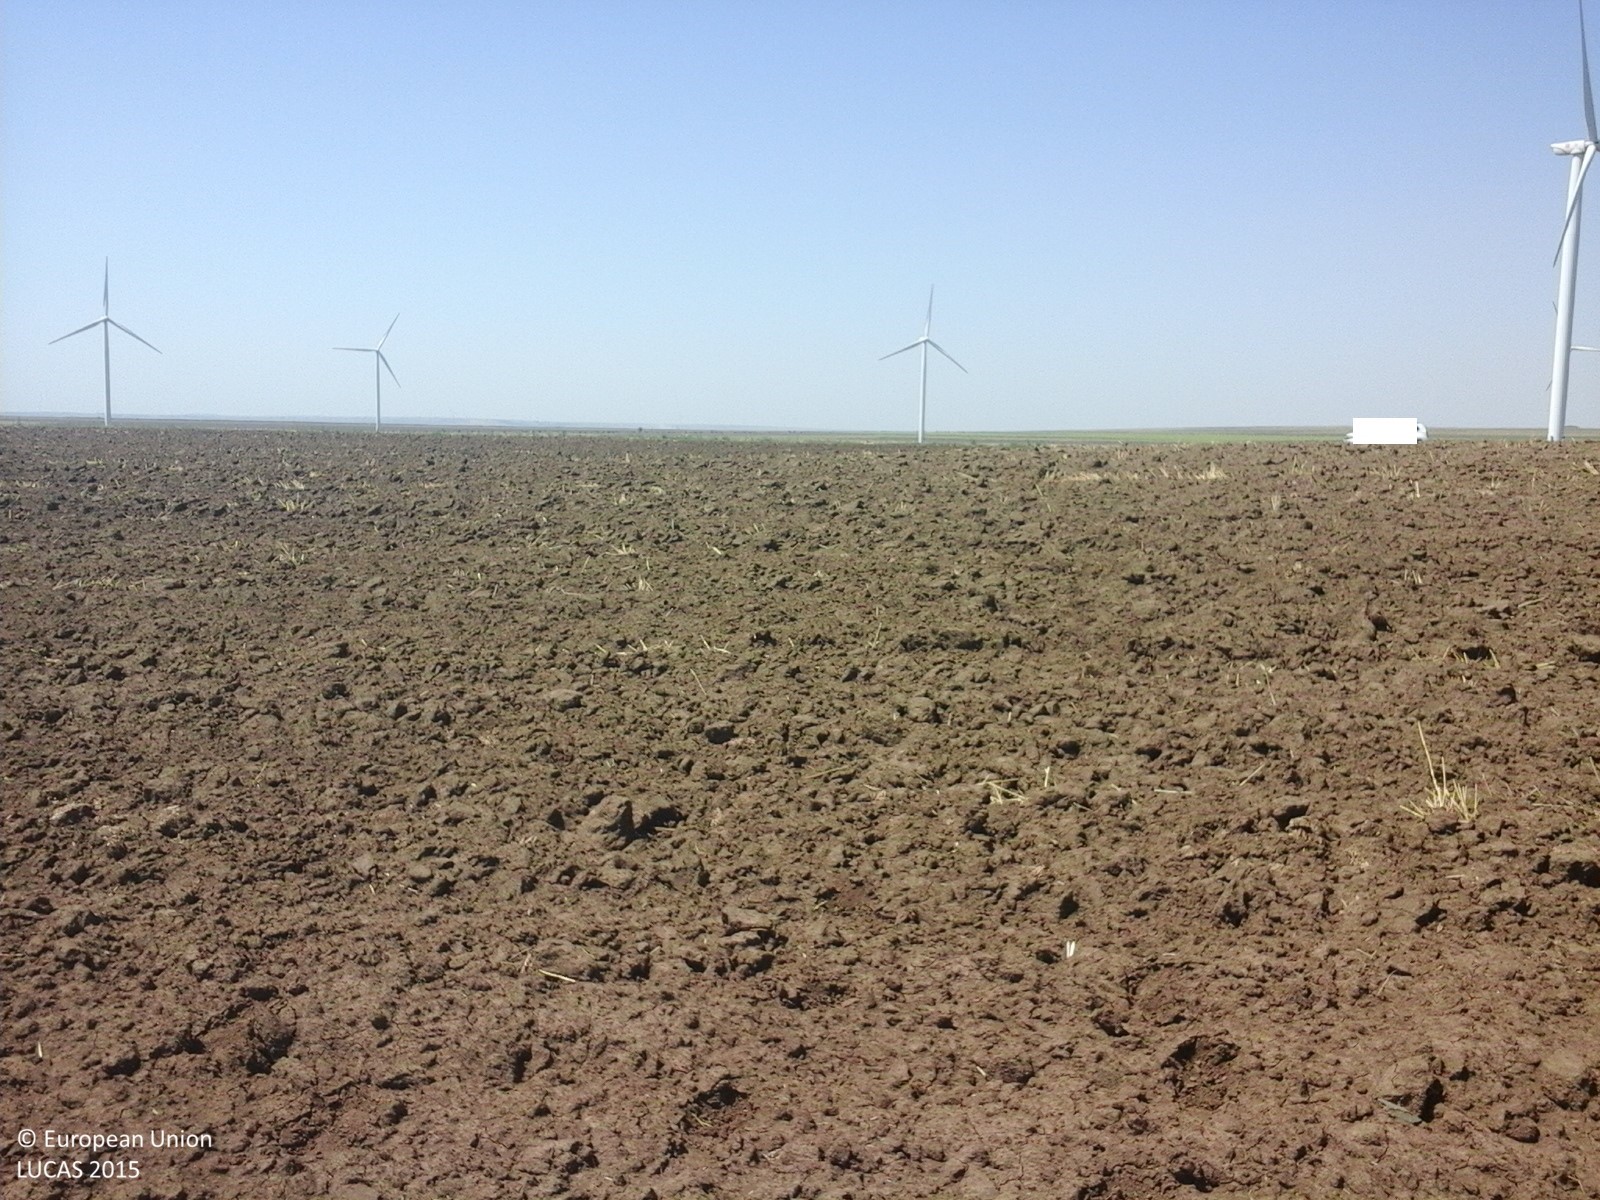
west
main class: Cropland
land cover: Common wheat
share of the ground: < 10 %
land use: Agriculture (excluding fallow land and kitchen gardens)
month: August
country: RO
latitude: 44.6022
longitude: 28.5328
